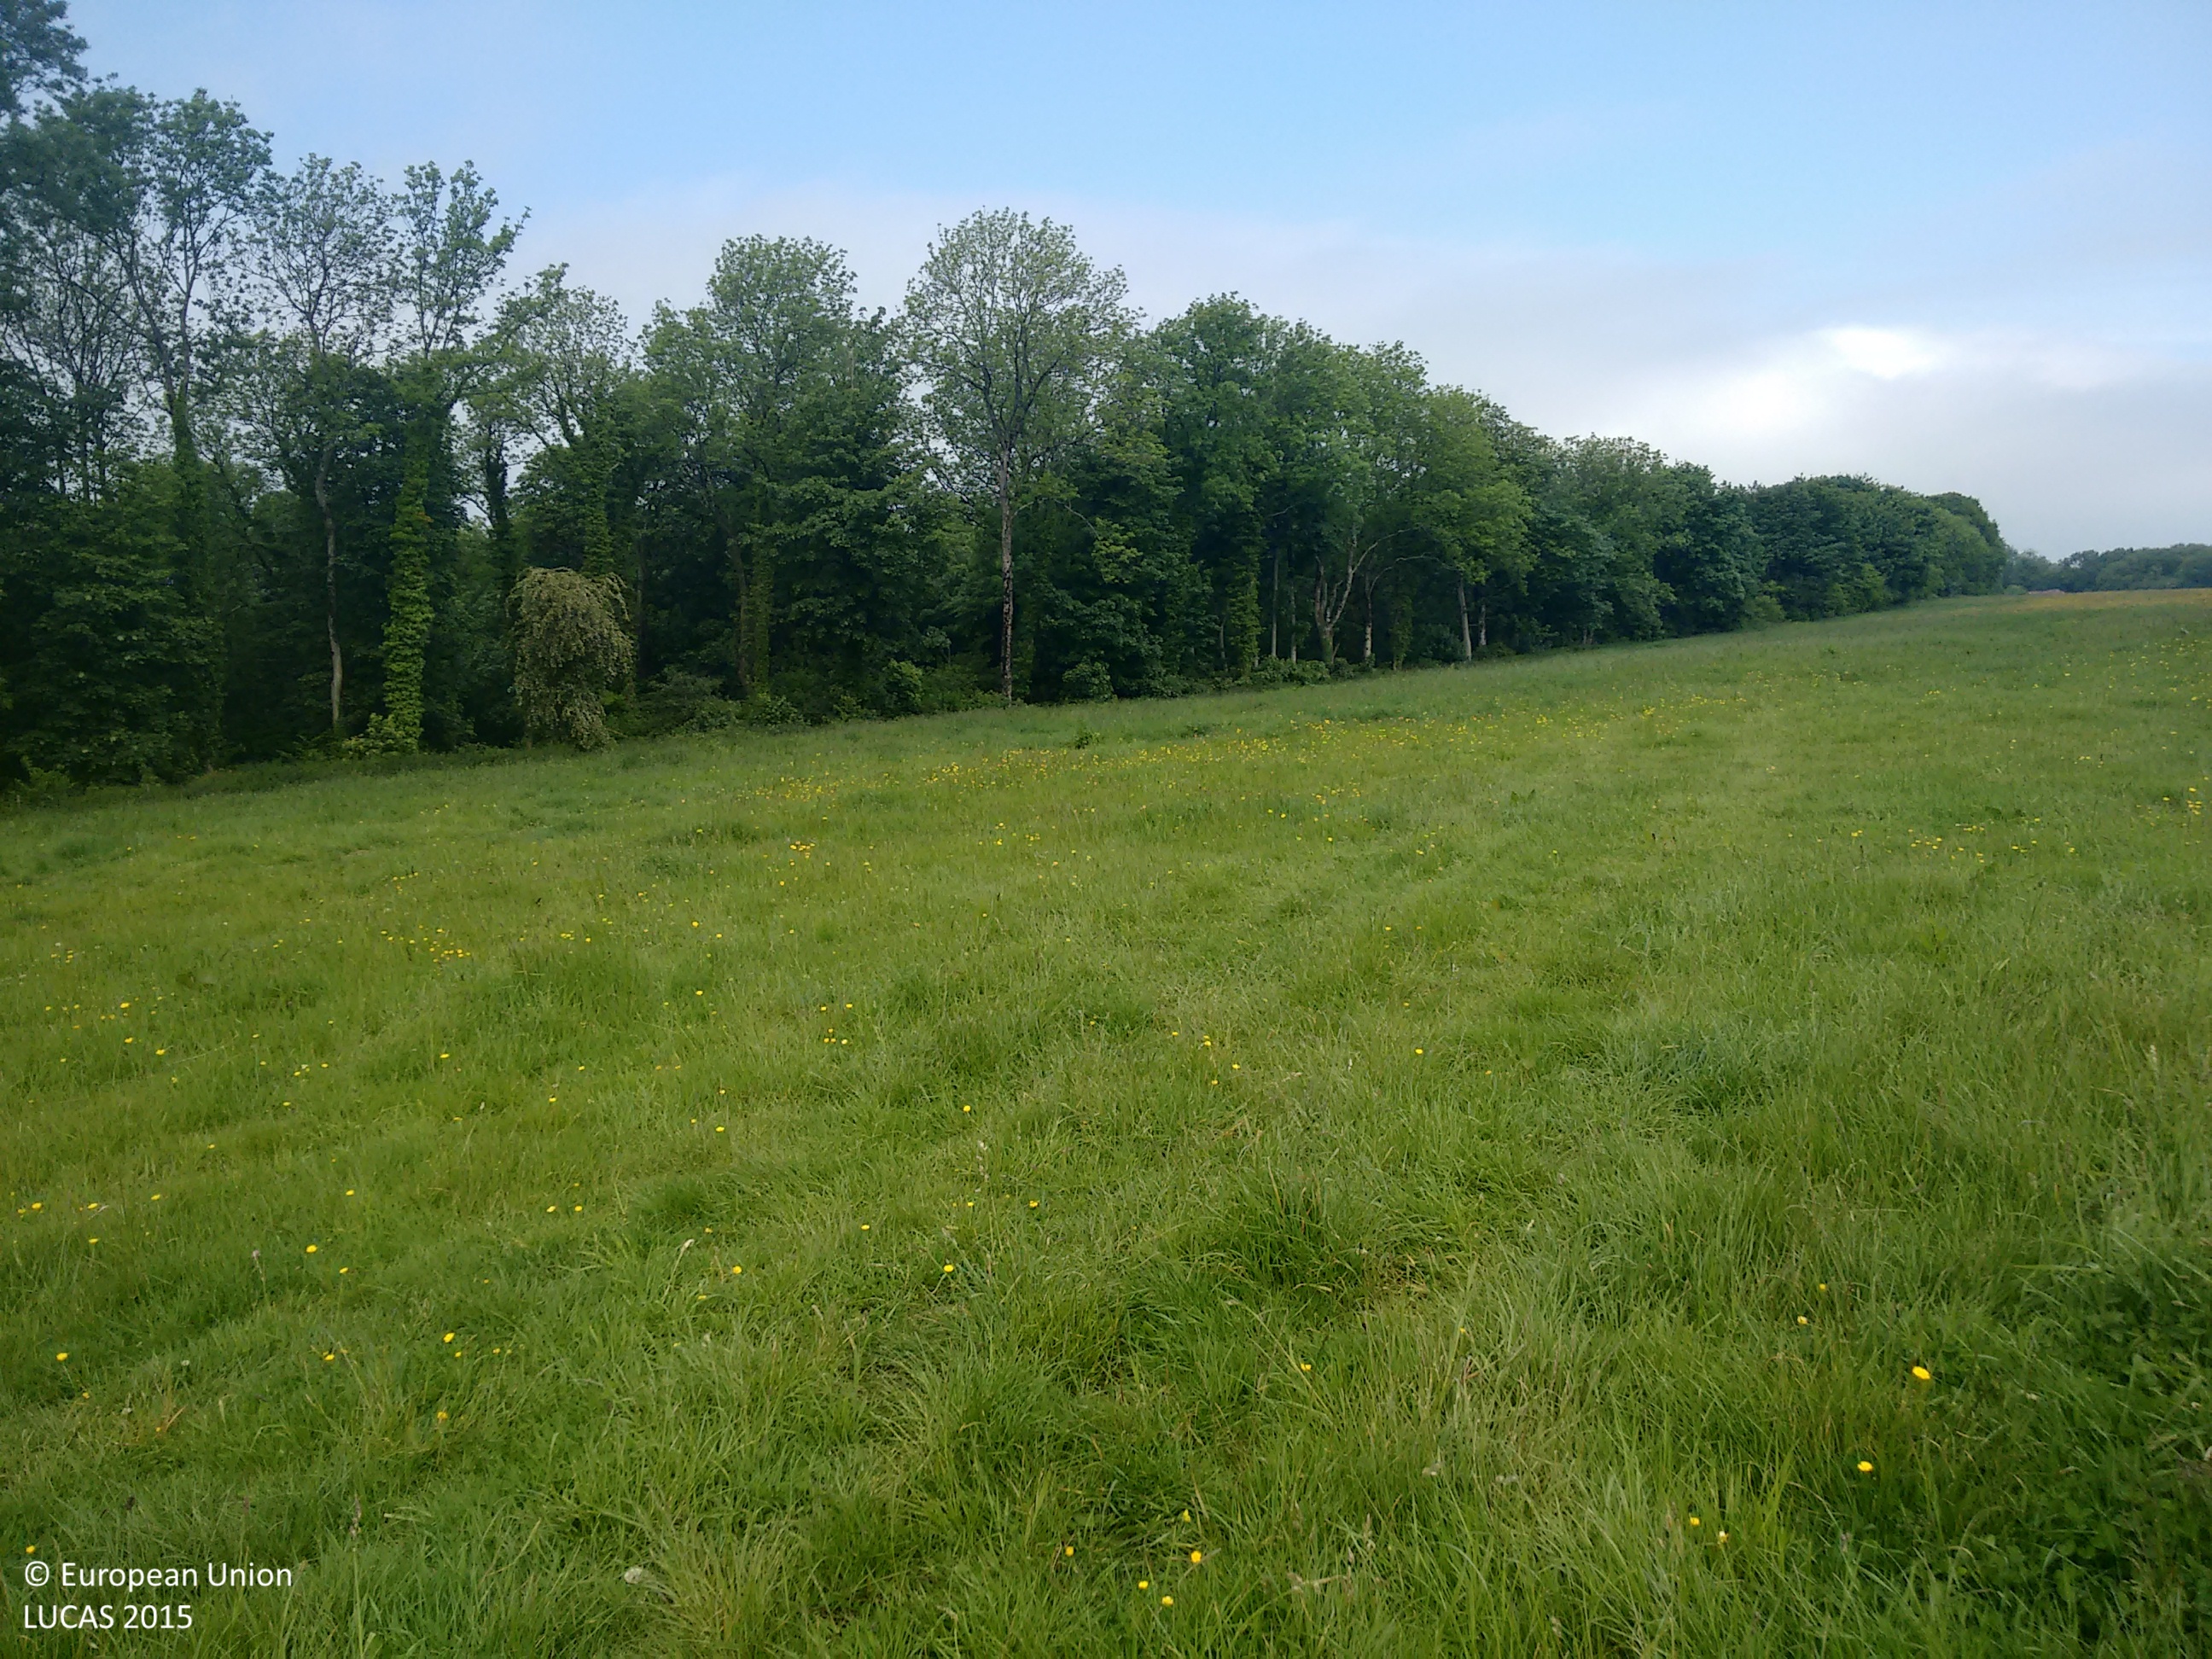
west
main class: Grassland
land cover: Grassland without tree/shrub cover
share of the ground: > 75 %
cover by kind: herbaceous plants 100 %
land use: Agriculture (excluding fallow land and kitchen gardens)
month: June
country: GB
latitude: 50.8443
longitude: -2.2908
